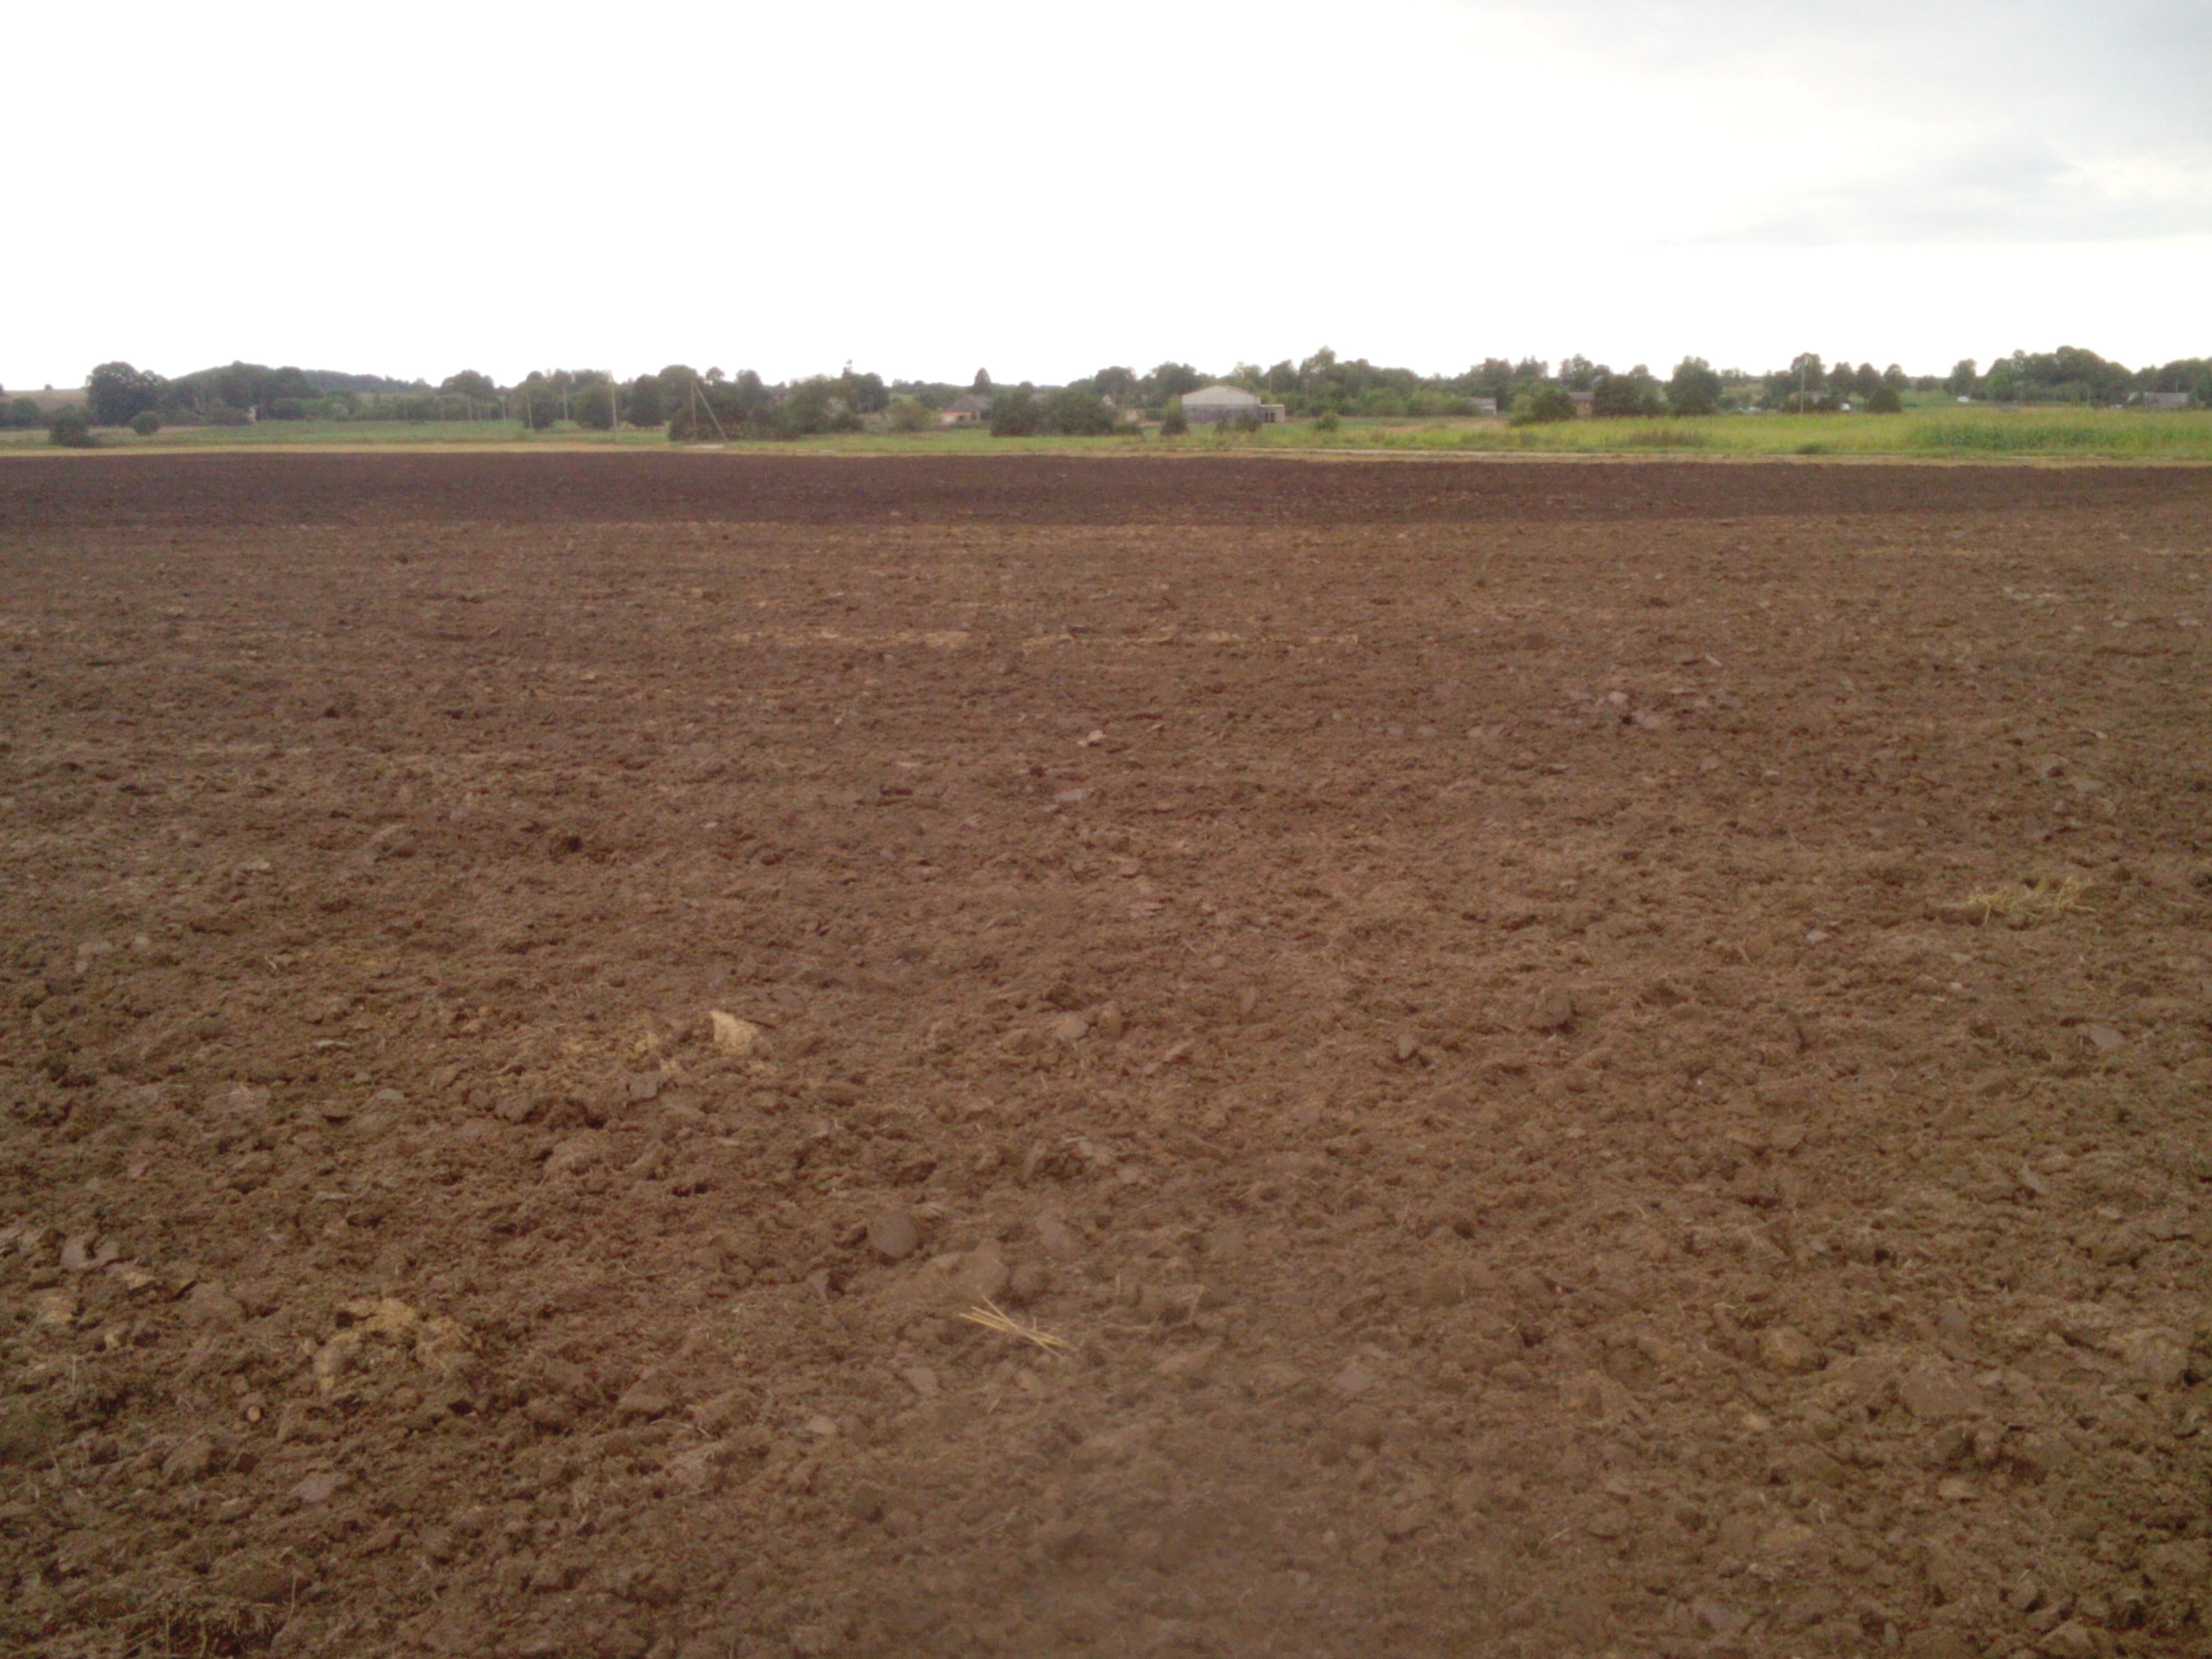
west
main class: Cropland
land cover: Common wheat
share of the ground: < 10 %
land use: Agriculture (excluding fallow land and kitchen gardens)
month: September
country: LT
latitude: 55.8133
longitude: 22.6532
